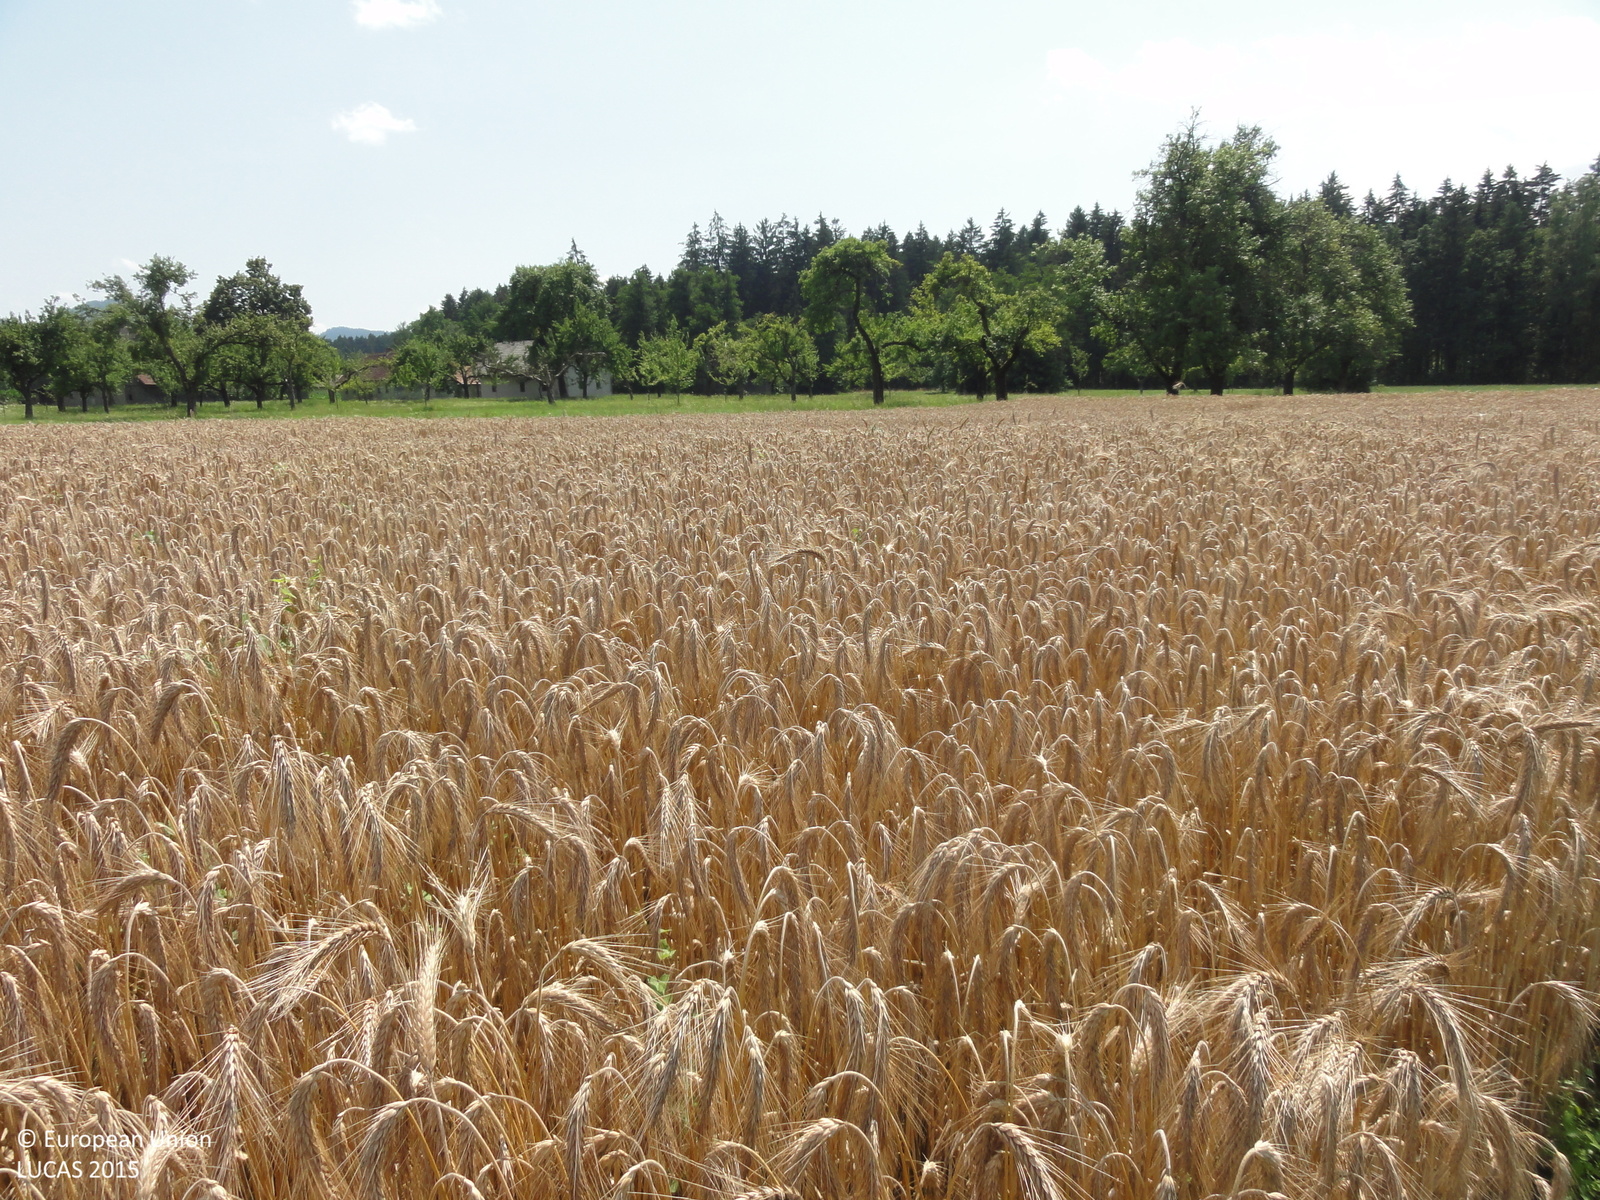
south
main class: Cropland
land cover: Common wheat
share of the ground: > 75 %
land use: Agriculture (excluding fallow land and kitchen gardens)
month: July
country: SI
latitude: 46.4814
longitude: 15.1172
